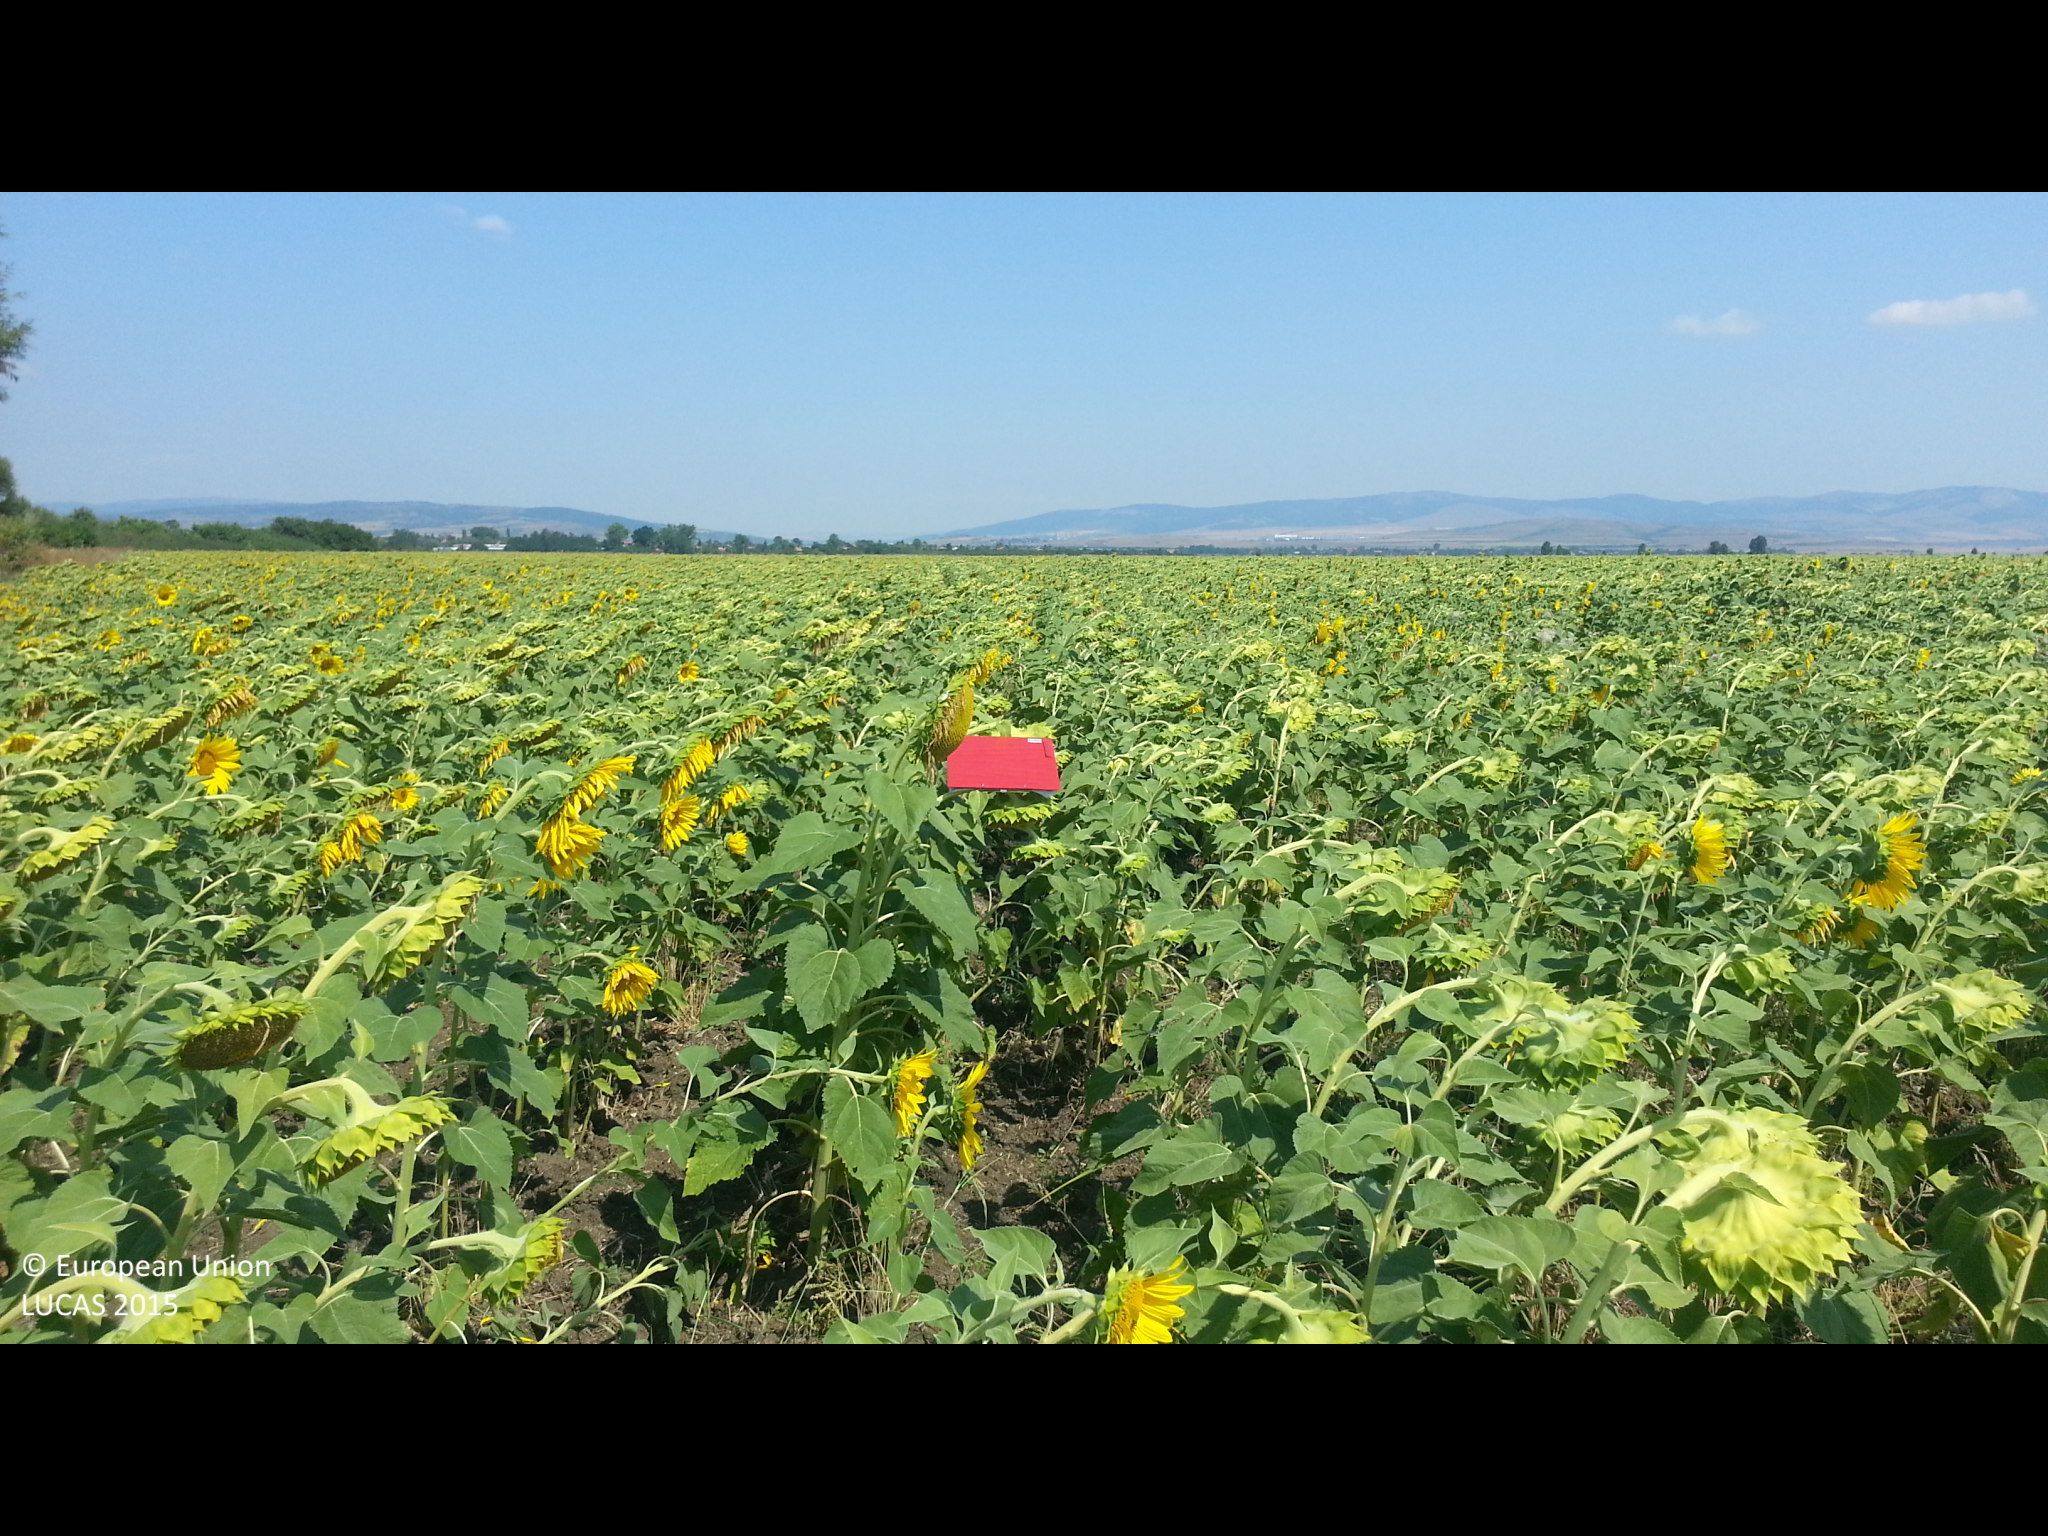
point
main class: Cropland
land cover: Sunflower
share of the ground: > 75 %
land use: Agriculture (excluding fallow land and kitchen gardens)
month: August
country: BG
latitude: 42.4399
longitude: 22.9494
